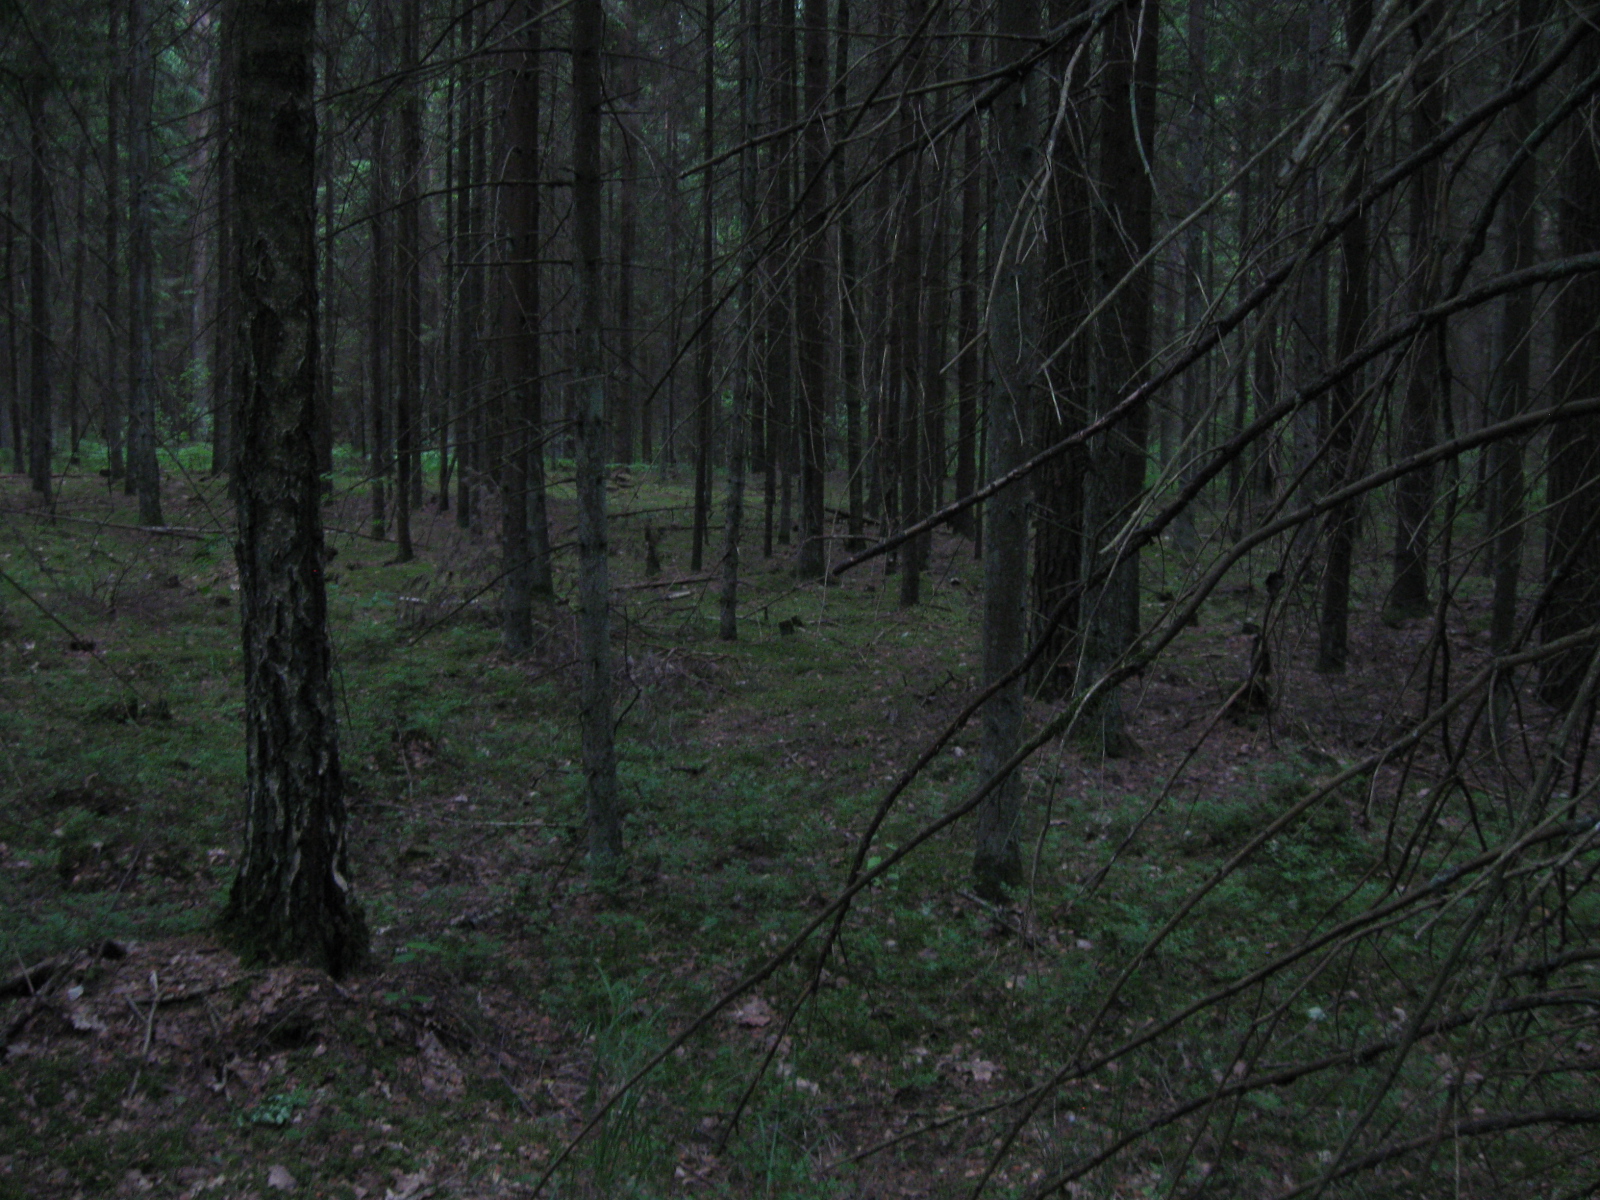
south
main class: Woodland
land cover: Spruce dominated coniferous woodland
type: hemiboreal forest and nemoral coniferous forest and mixed broadleaved-coniferous forest
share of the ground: > 75 %
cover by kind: coniferous forest trees 75 %, broadleaved forest trees 20 %, herbaceous plants 5 %
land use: Forestry
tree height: > 5 m
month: June
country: LT
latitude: 55.0166
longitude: 24.6018
